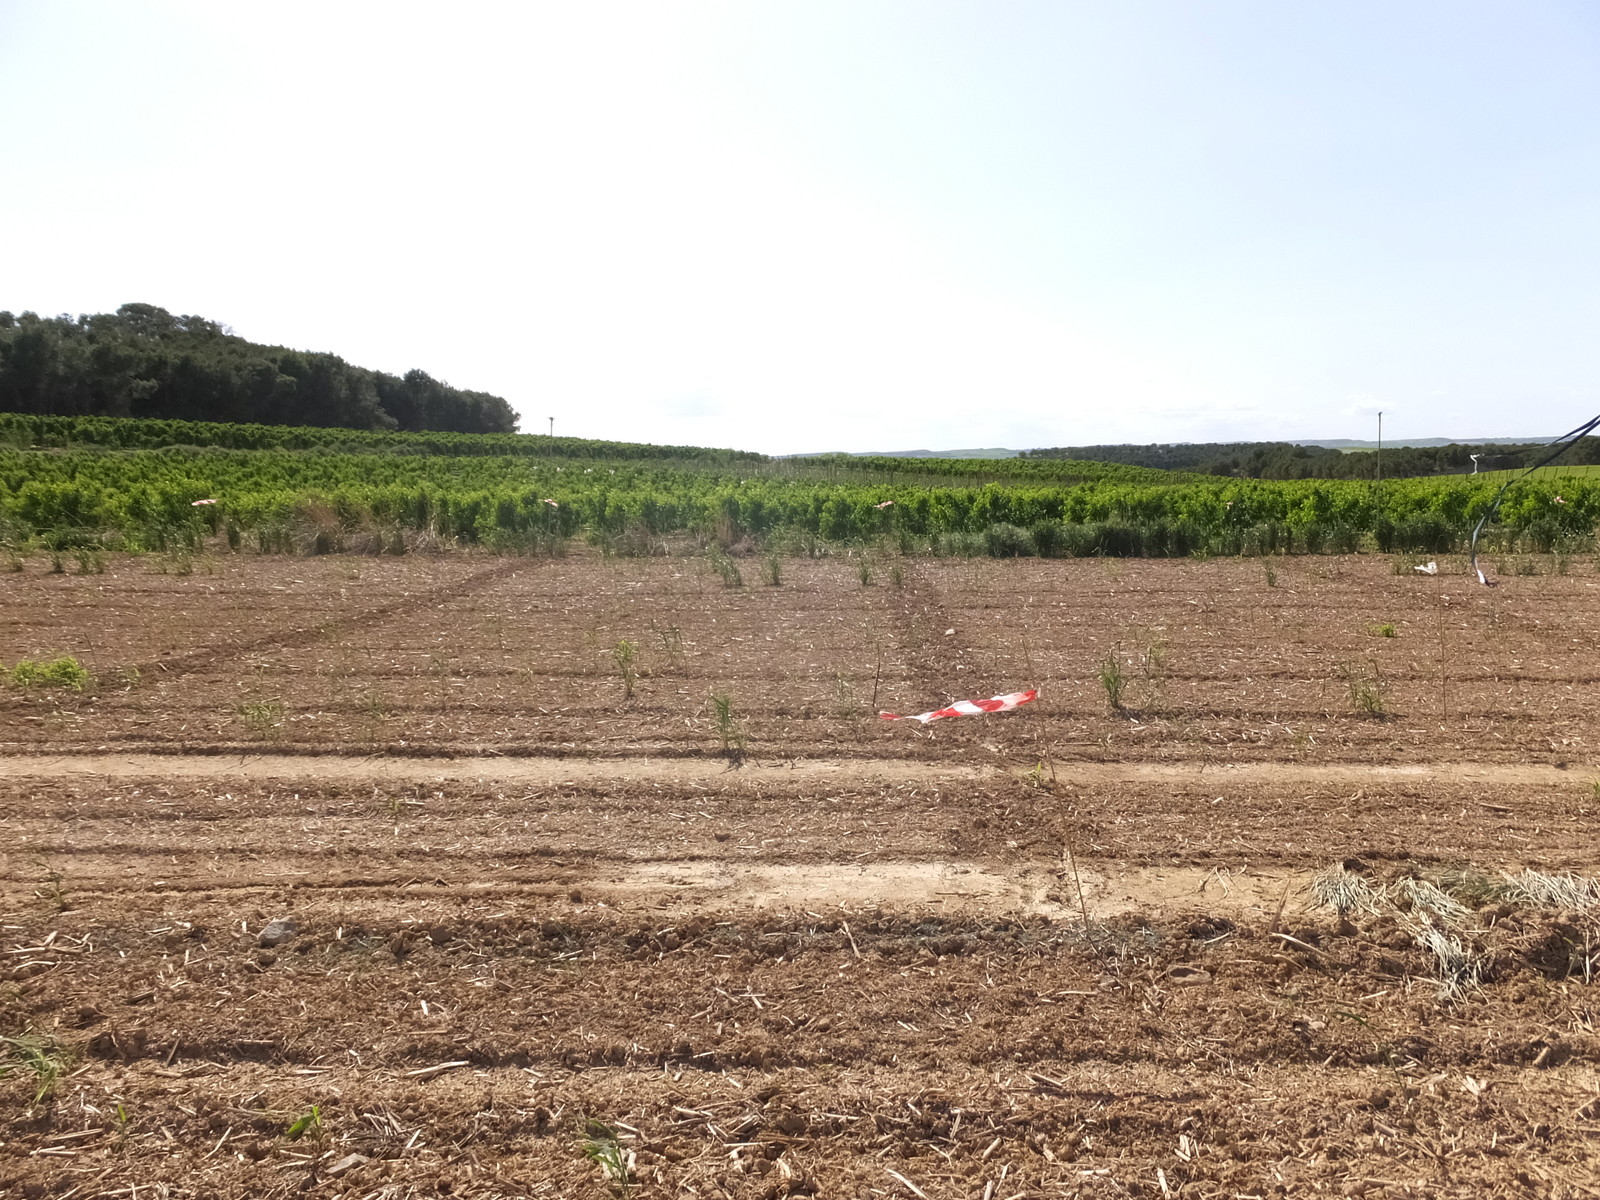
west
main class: Cropland
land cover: Maize
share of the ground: 10 - 25 %
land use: Agriculture (excluding fallow land and kitchen gardens)
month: May
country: ES
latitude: 41.6642
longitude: 0.3420
